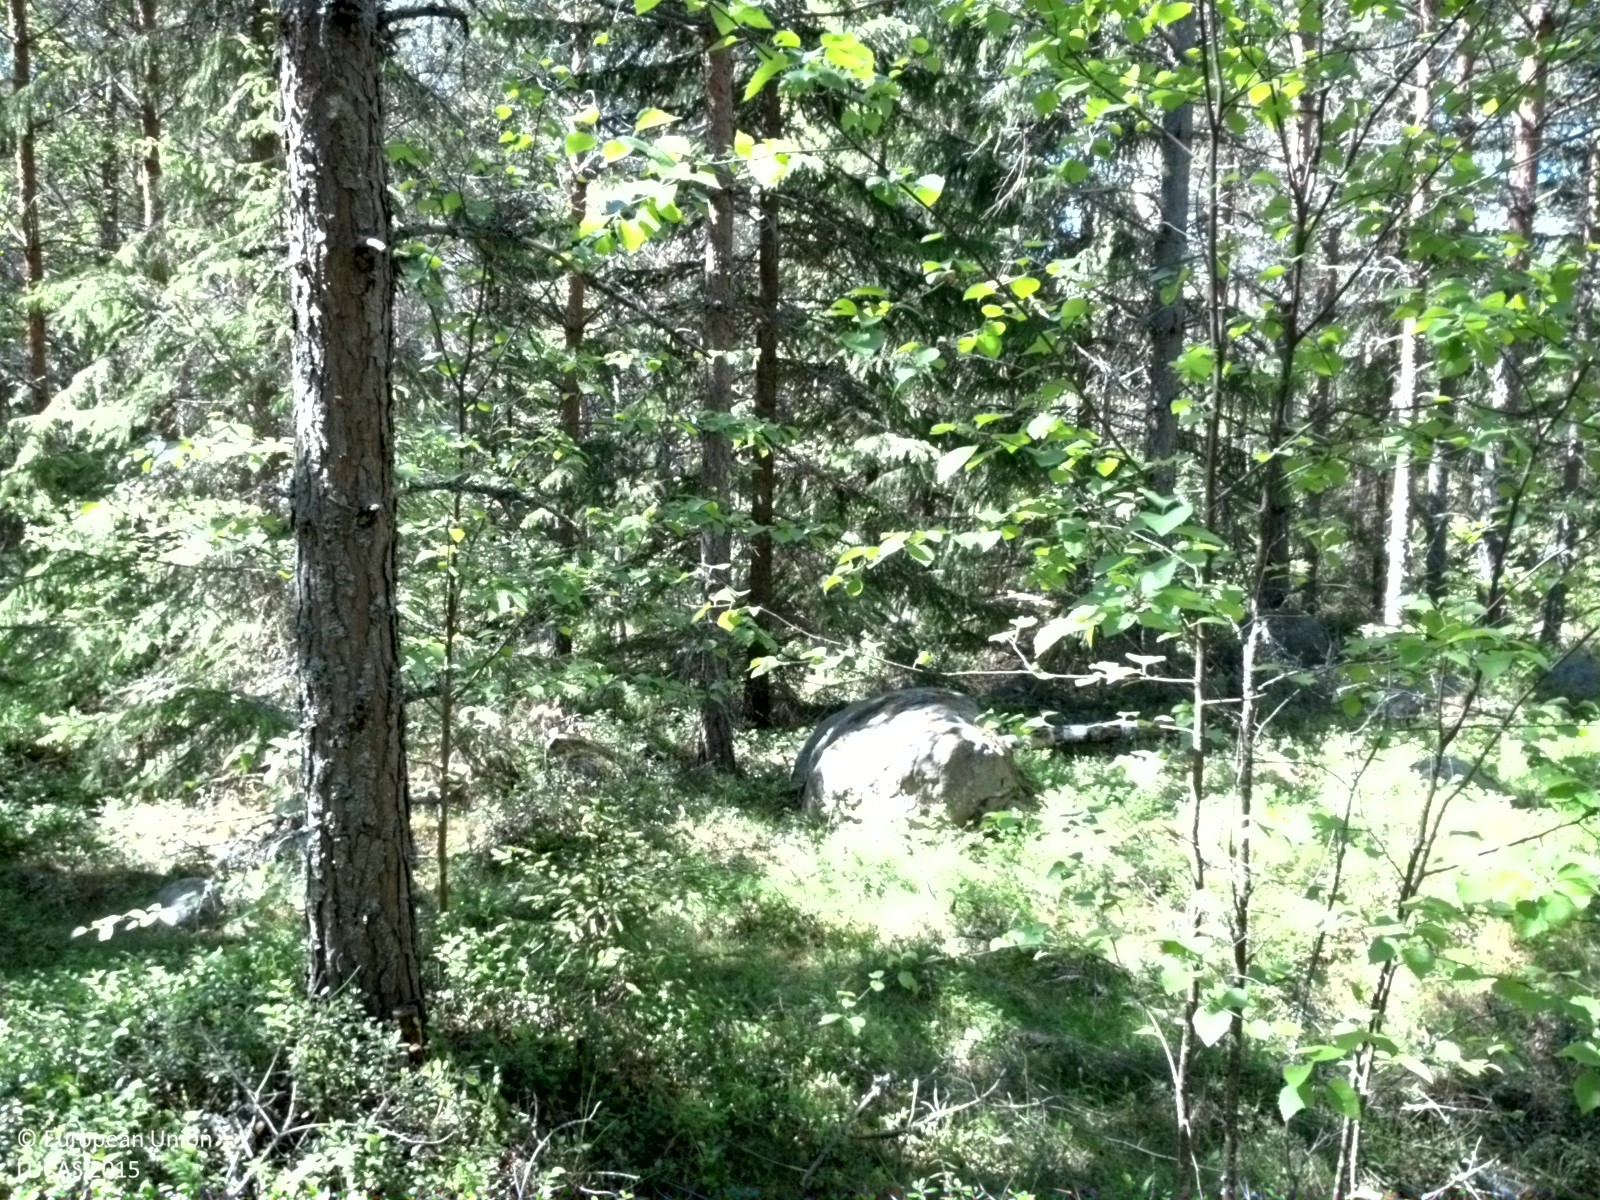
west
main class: Woodland
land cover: Pine dominated coniferous woodland
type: boreal forest
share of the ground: > 75 %
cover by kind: coniferous forest trees 70 %, broadleaved forest trees 10 %, shrubs 10 %, herbaceous plants 5 %, consolidated bare surface 5 %
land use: Forestry
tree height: > 5 m
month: June
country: SE
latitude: 60.2095
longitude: 17.6255
